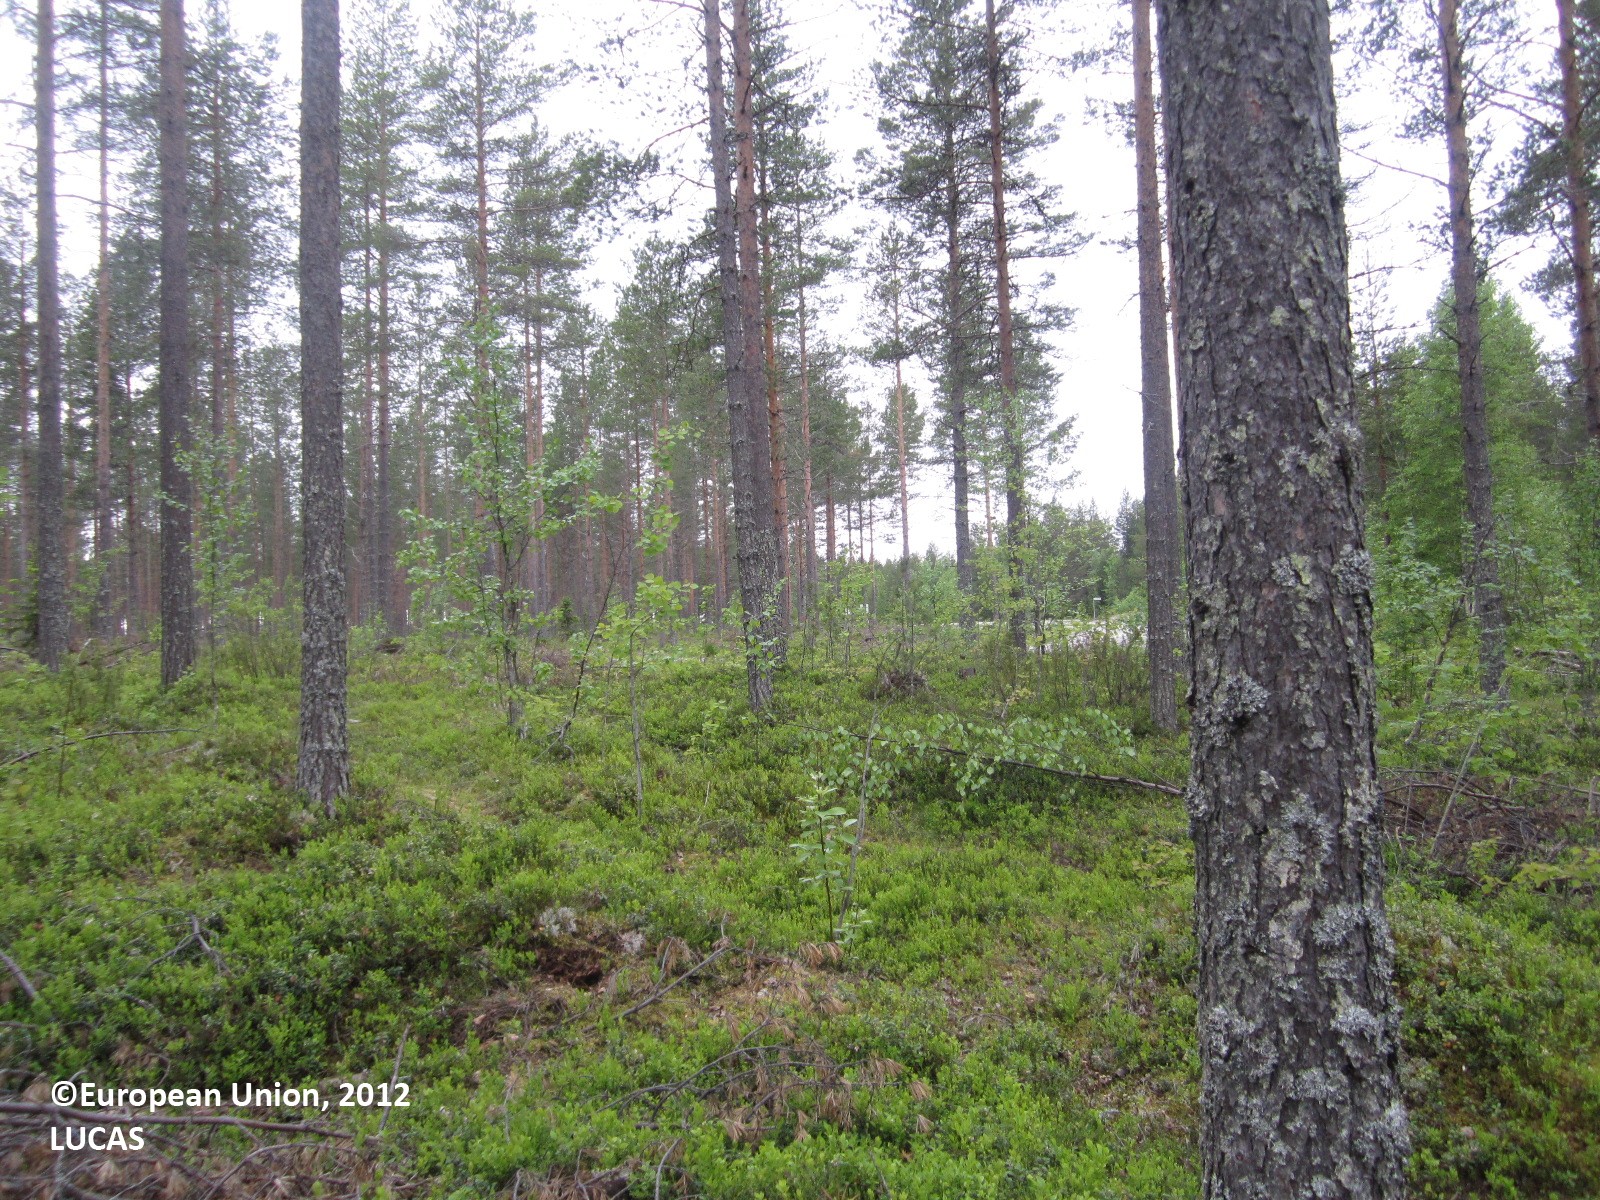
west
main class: Woodland
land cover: Pine dominated coniferous woodland
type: boreal forest
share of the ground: 50 - 75 %
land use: Forestry
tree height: > 5 m
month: June
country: FI
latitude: 64.4580
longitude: 29.5258
